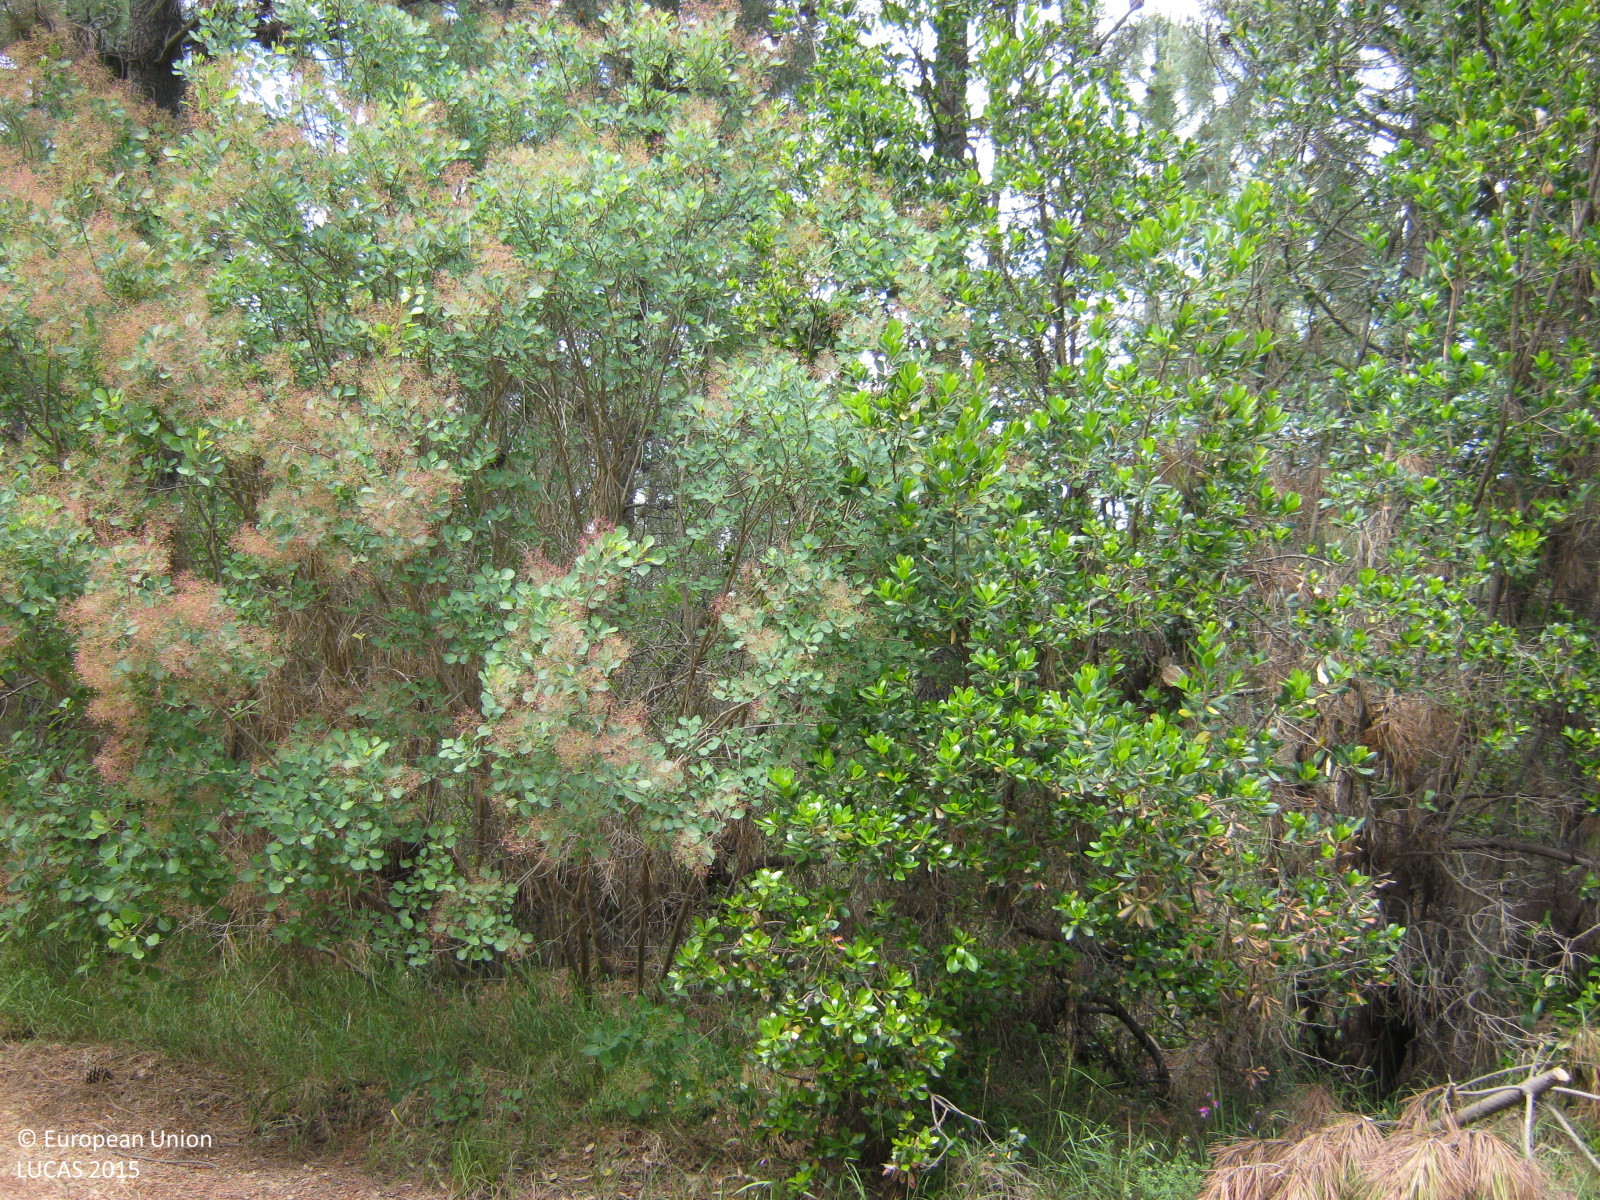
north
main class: Woodland
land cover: Pine dominated coniferous woodland
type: coniferous forest of the mediterranean region
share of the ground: > 75 %
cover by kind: coniferous forest trees 80 %, broadleaved forest trees 10 %, shrubs 10 %
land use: Forestry
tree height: > 5 m
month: May
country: GR
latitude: 37.2926
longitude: 22.3104
